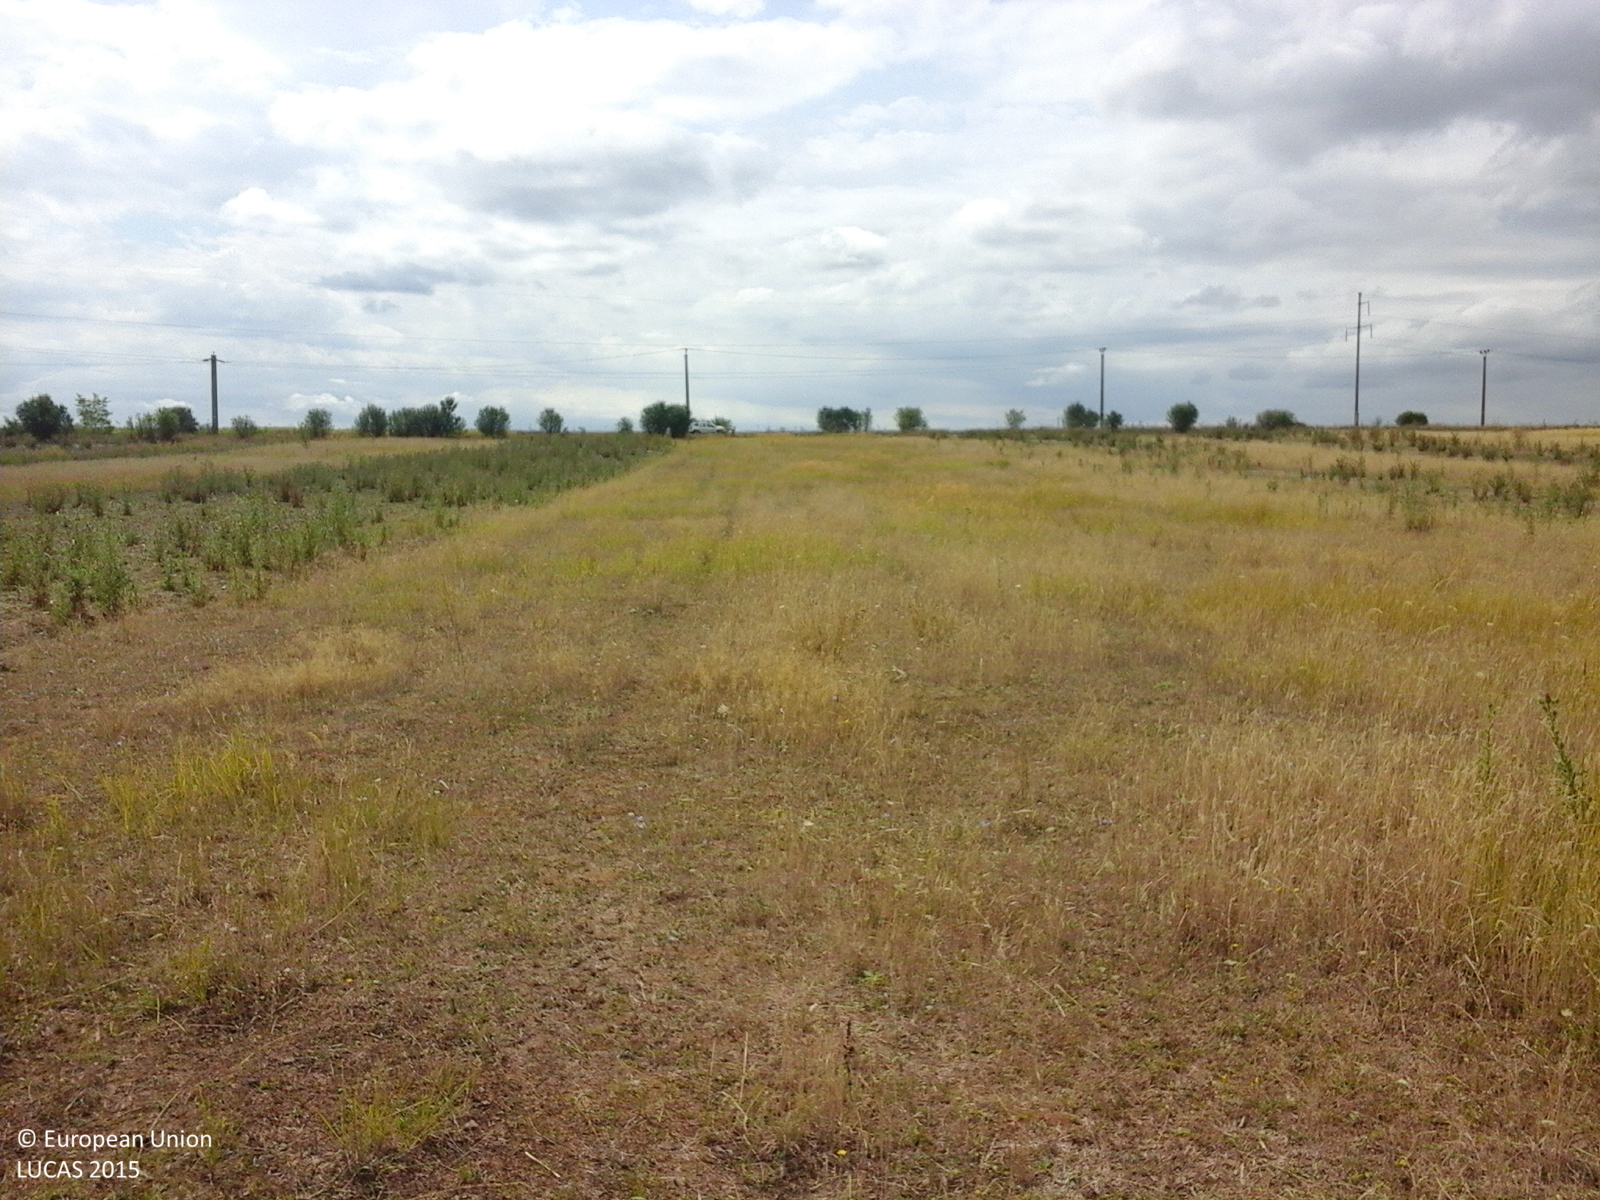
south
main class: Grassland
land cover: Grassland without tree/shrub cover
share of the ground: > 75 %
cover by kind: herbaceous plants 100 %
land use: Agriculture (excluding fallow land and kitchen gardens)
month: August
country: RO
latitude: 45.4267
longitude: 21.5999
